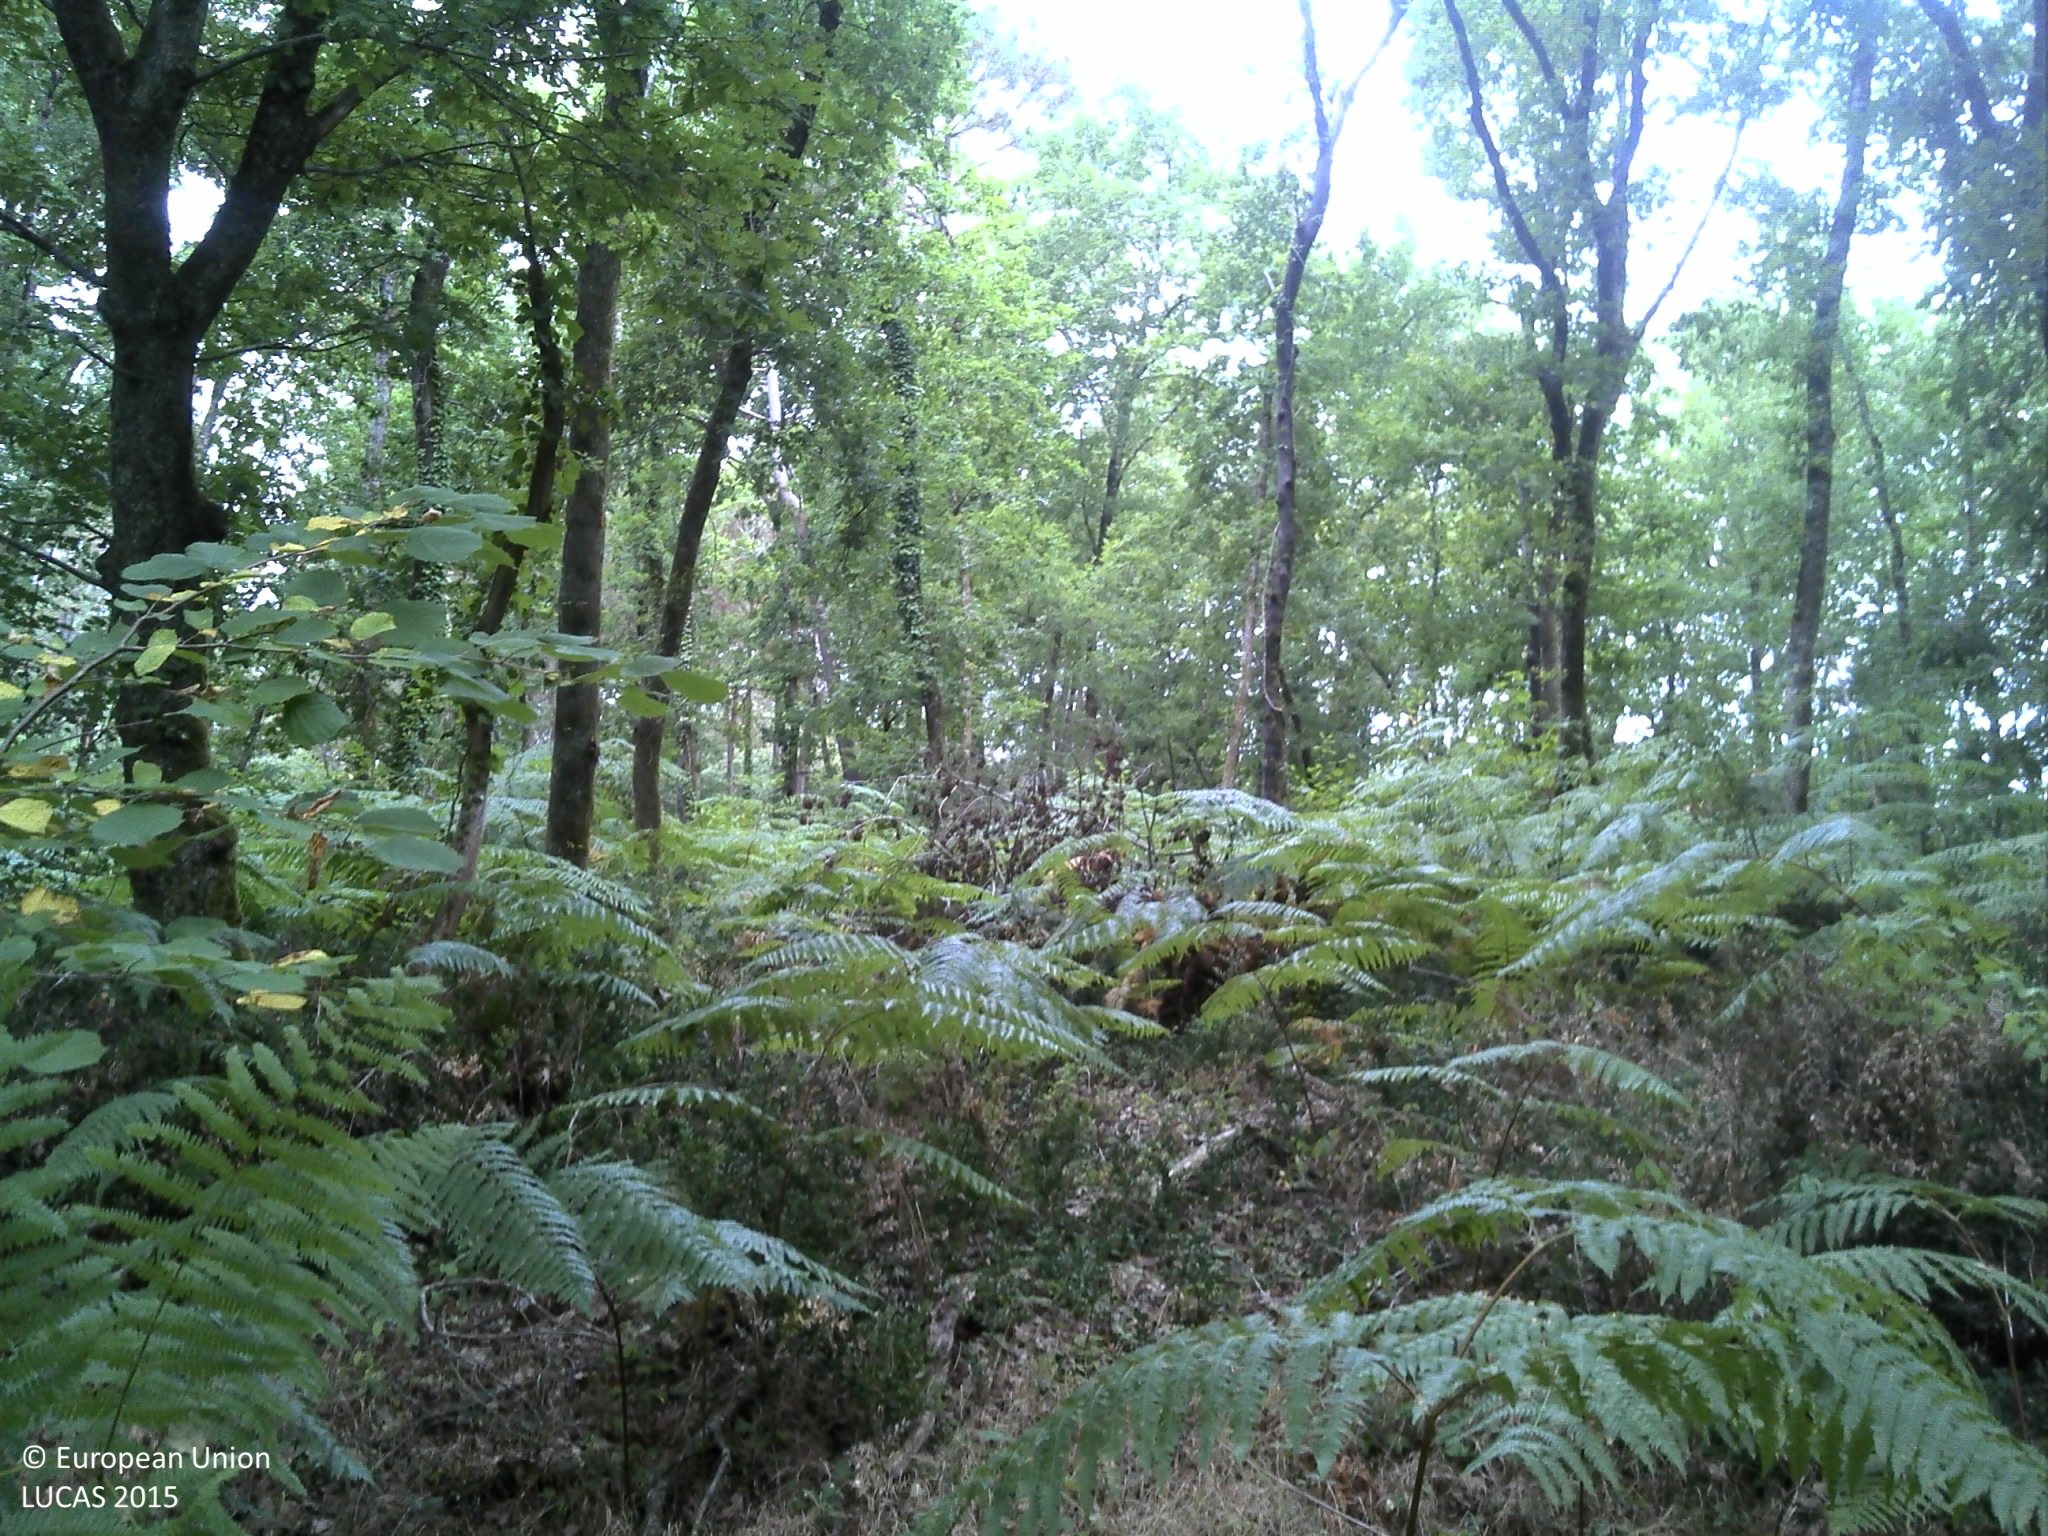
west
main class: Woodland
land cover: Broadleaved woodland
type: floodplain forest
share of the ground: > 75 %
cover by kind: broadleaved forest trees 70 %, shrubs 20 %, herbaceous plants 5 %, lichens and mosses 5 %
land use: Forestry
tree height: > 5 m
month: July
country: FR
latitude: 44.6630
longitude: -0.5738
